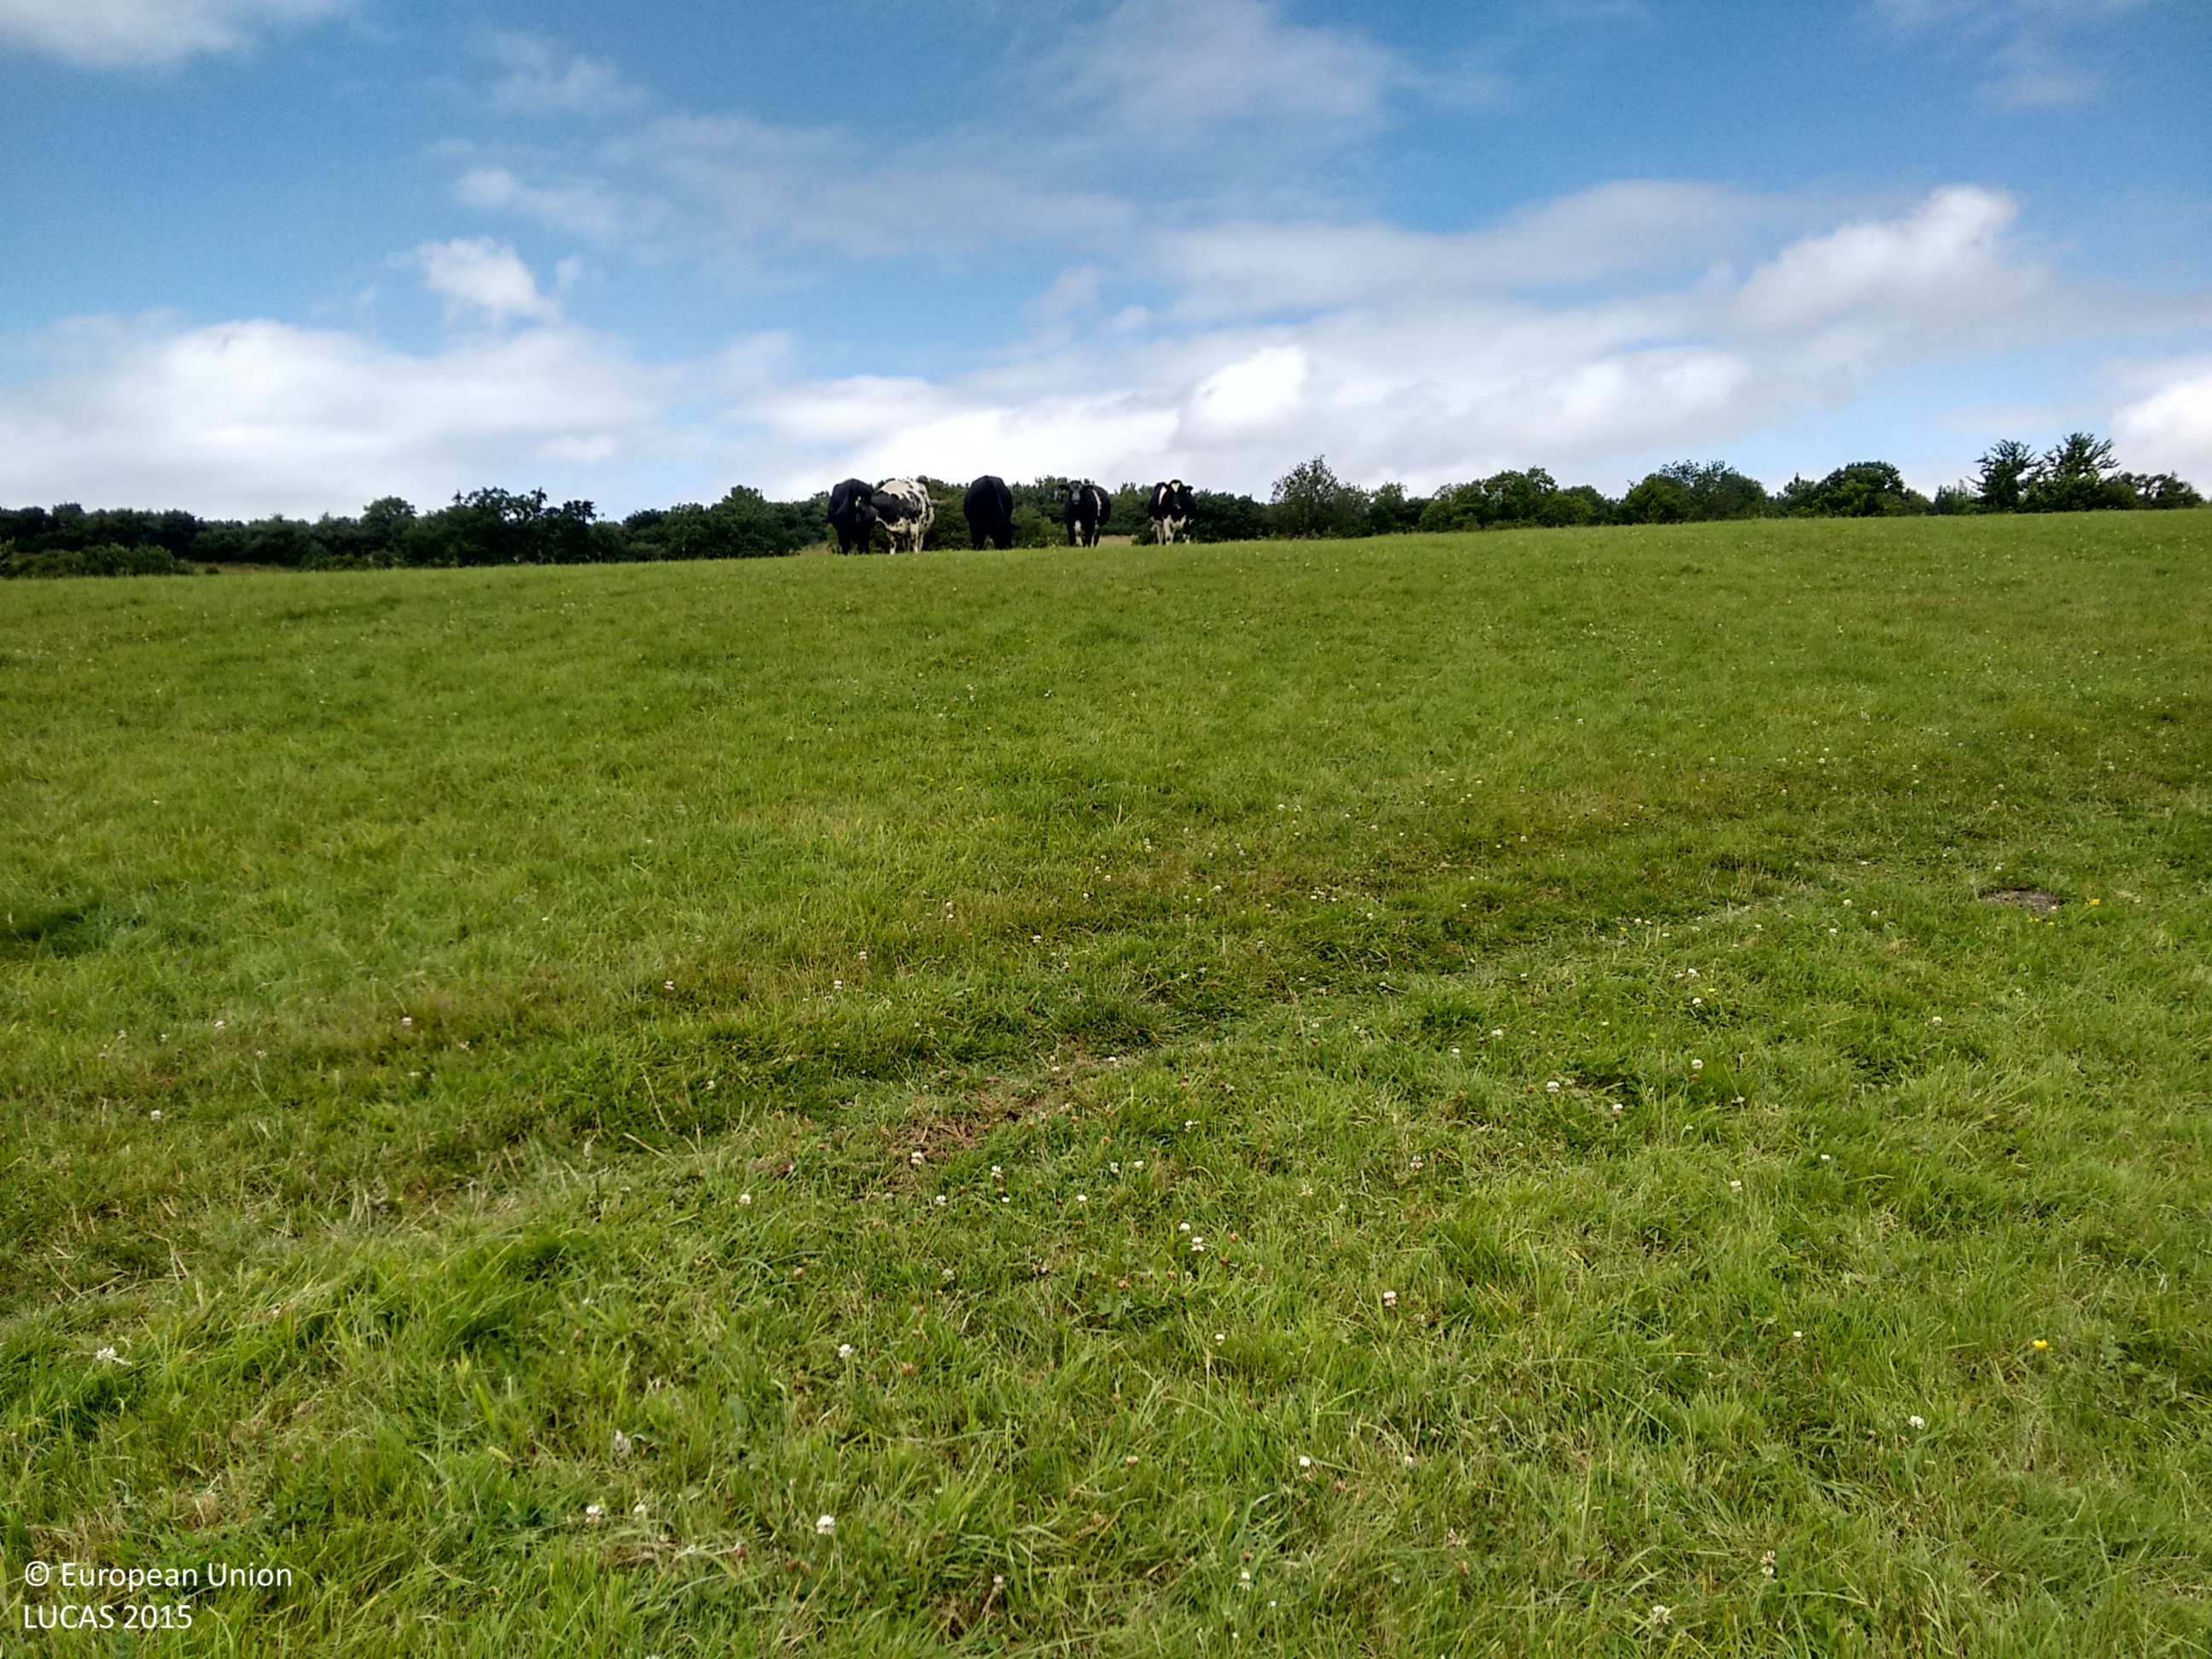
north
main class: Grassland
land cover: Grassland without tree/shrub cover
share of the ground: > 75 %
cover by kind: herbaceous plants 100 %
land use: Agriculture (excluding fallow land and kitchen gardens)
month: July
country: GB
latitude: 51.3832
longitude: -2.5245
